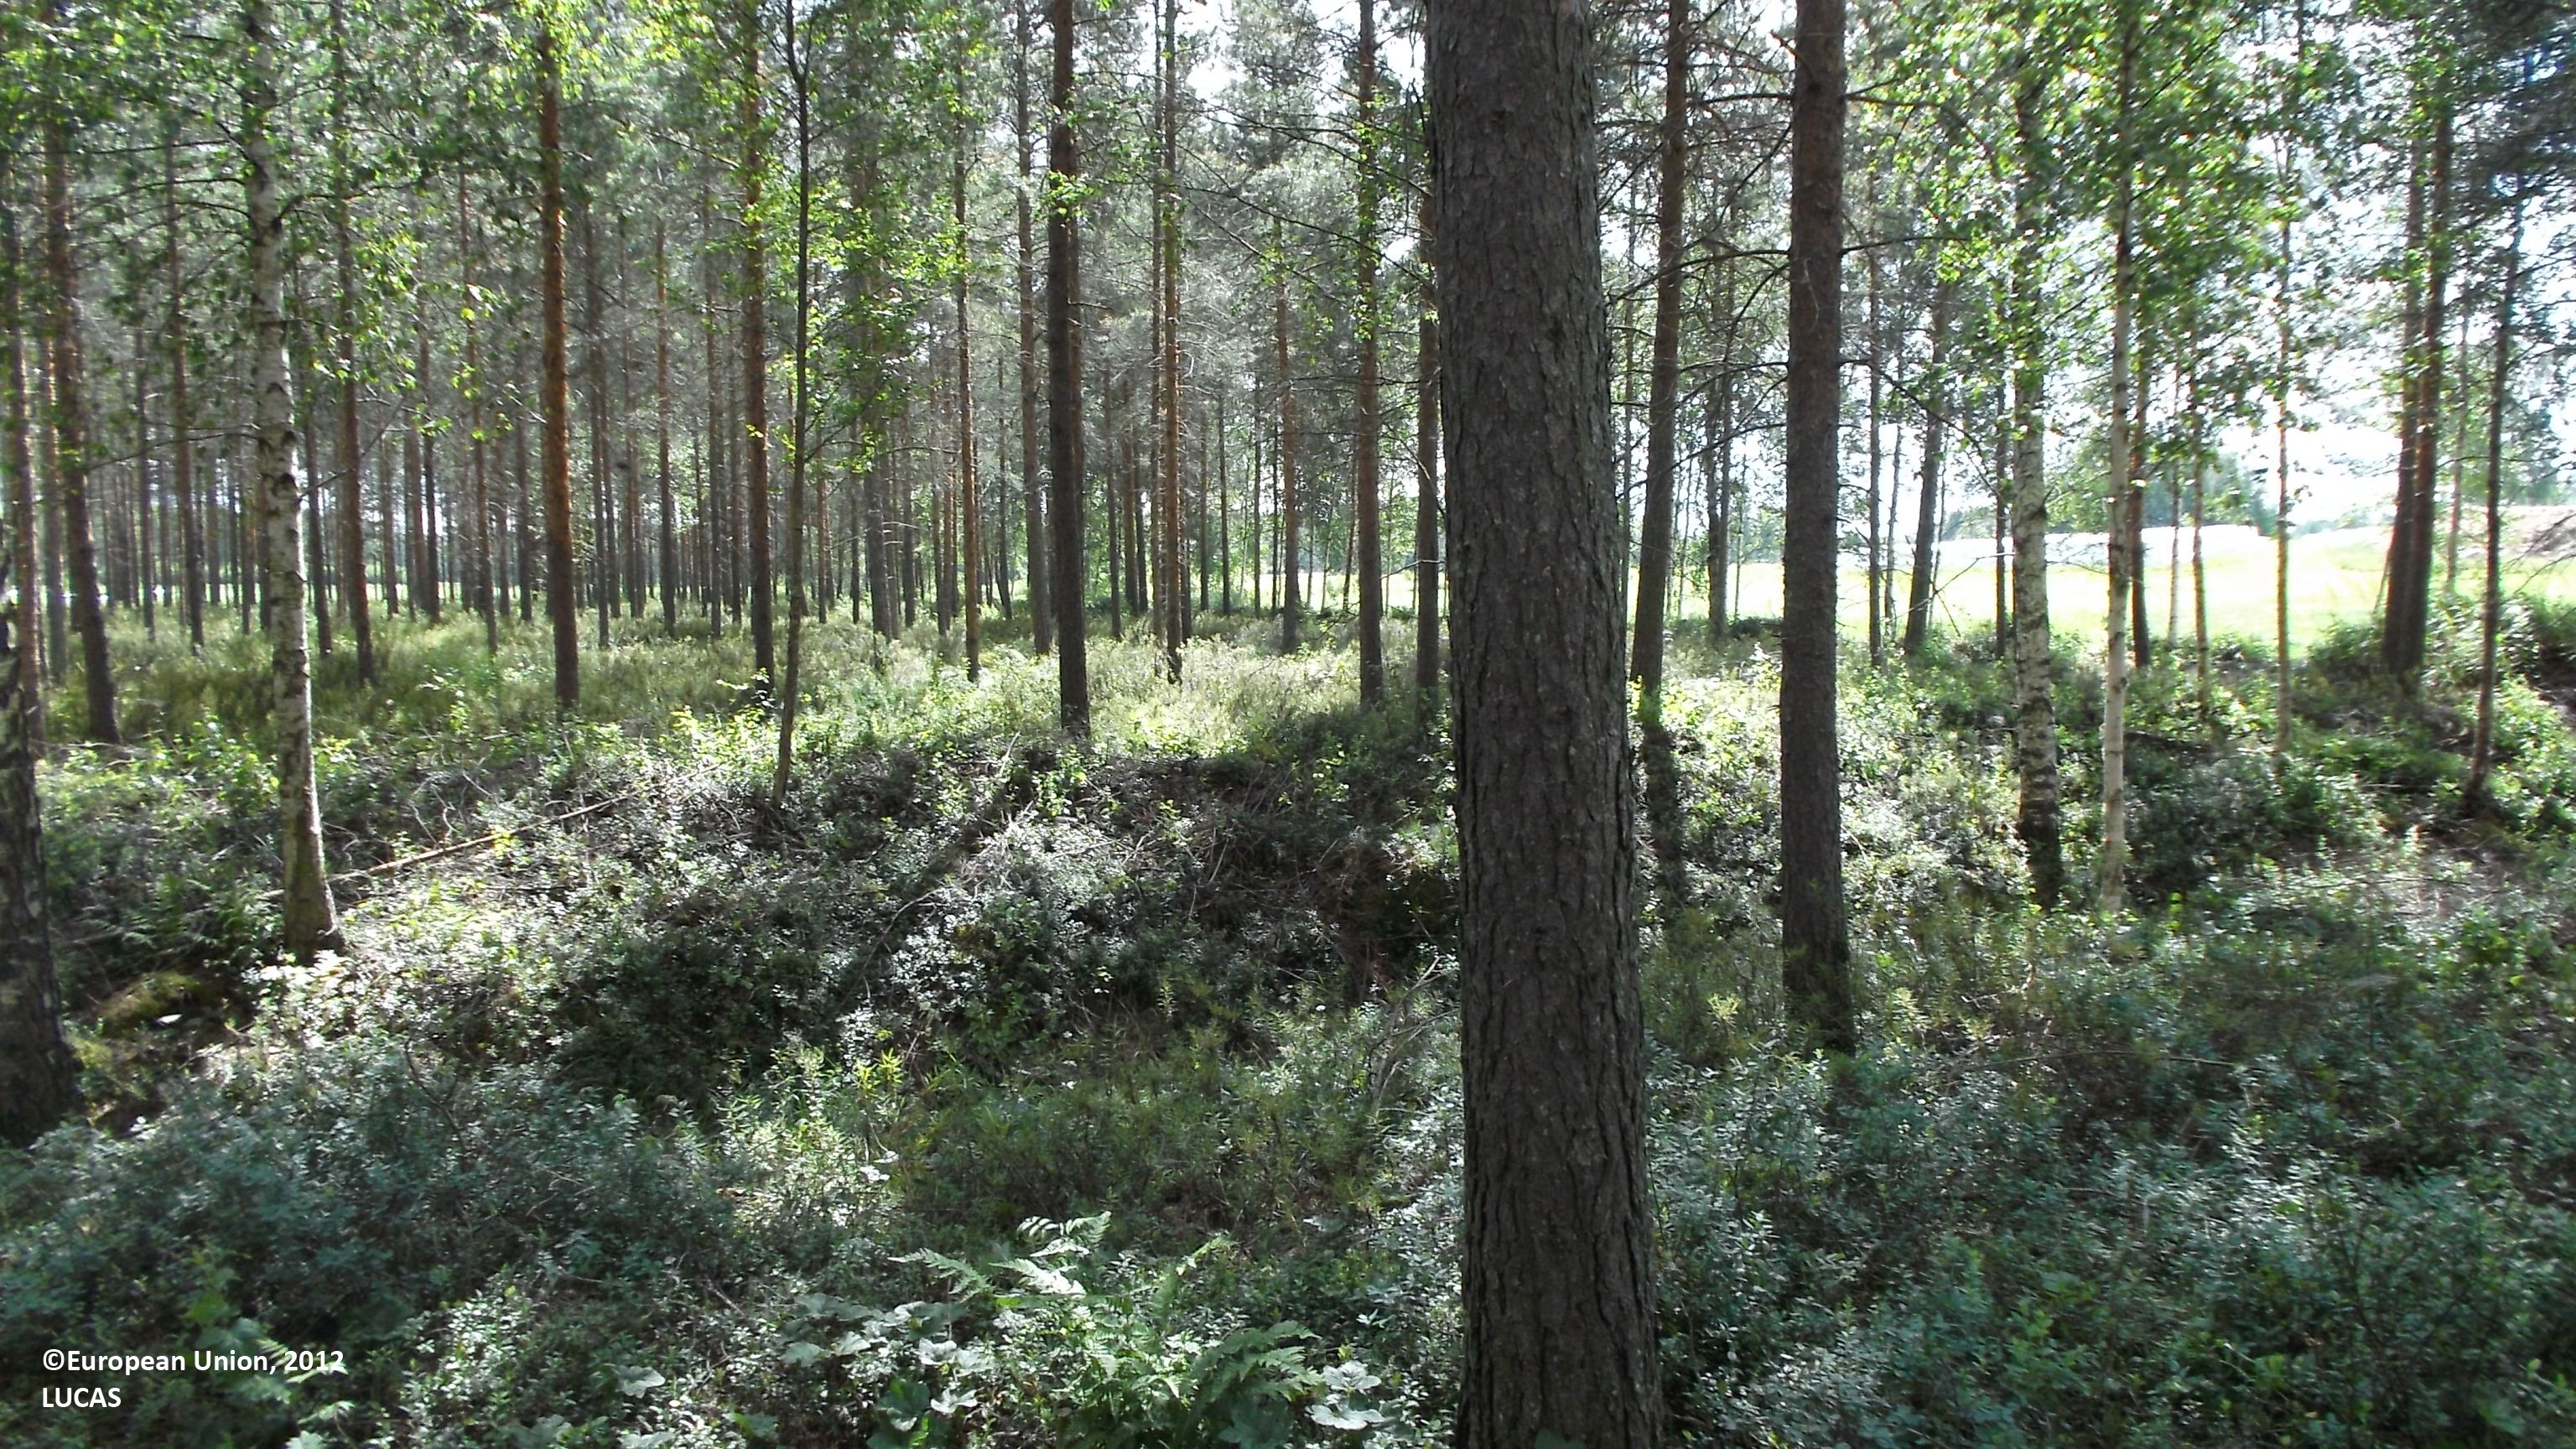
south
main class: Woodland
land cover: Pine dominated coniferous woodland
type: boreal forest
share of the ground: 25 - 50 %
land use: Forestry
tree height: > 5 m
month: July
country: FI
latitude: 63.3118
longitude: 23.8193
